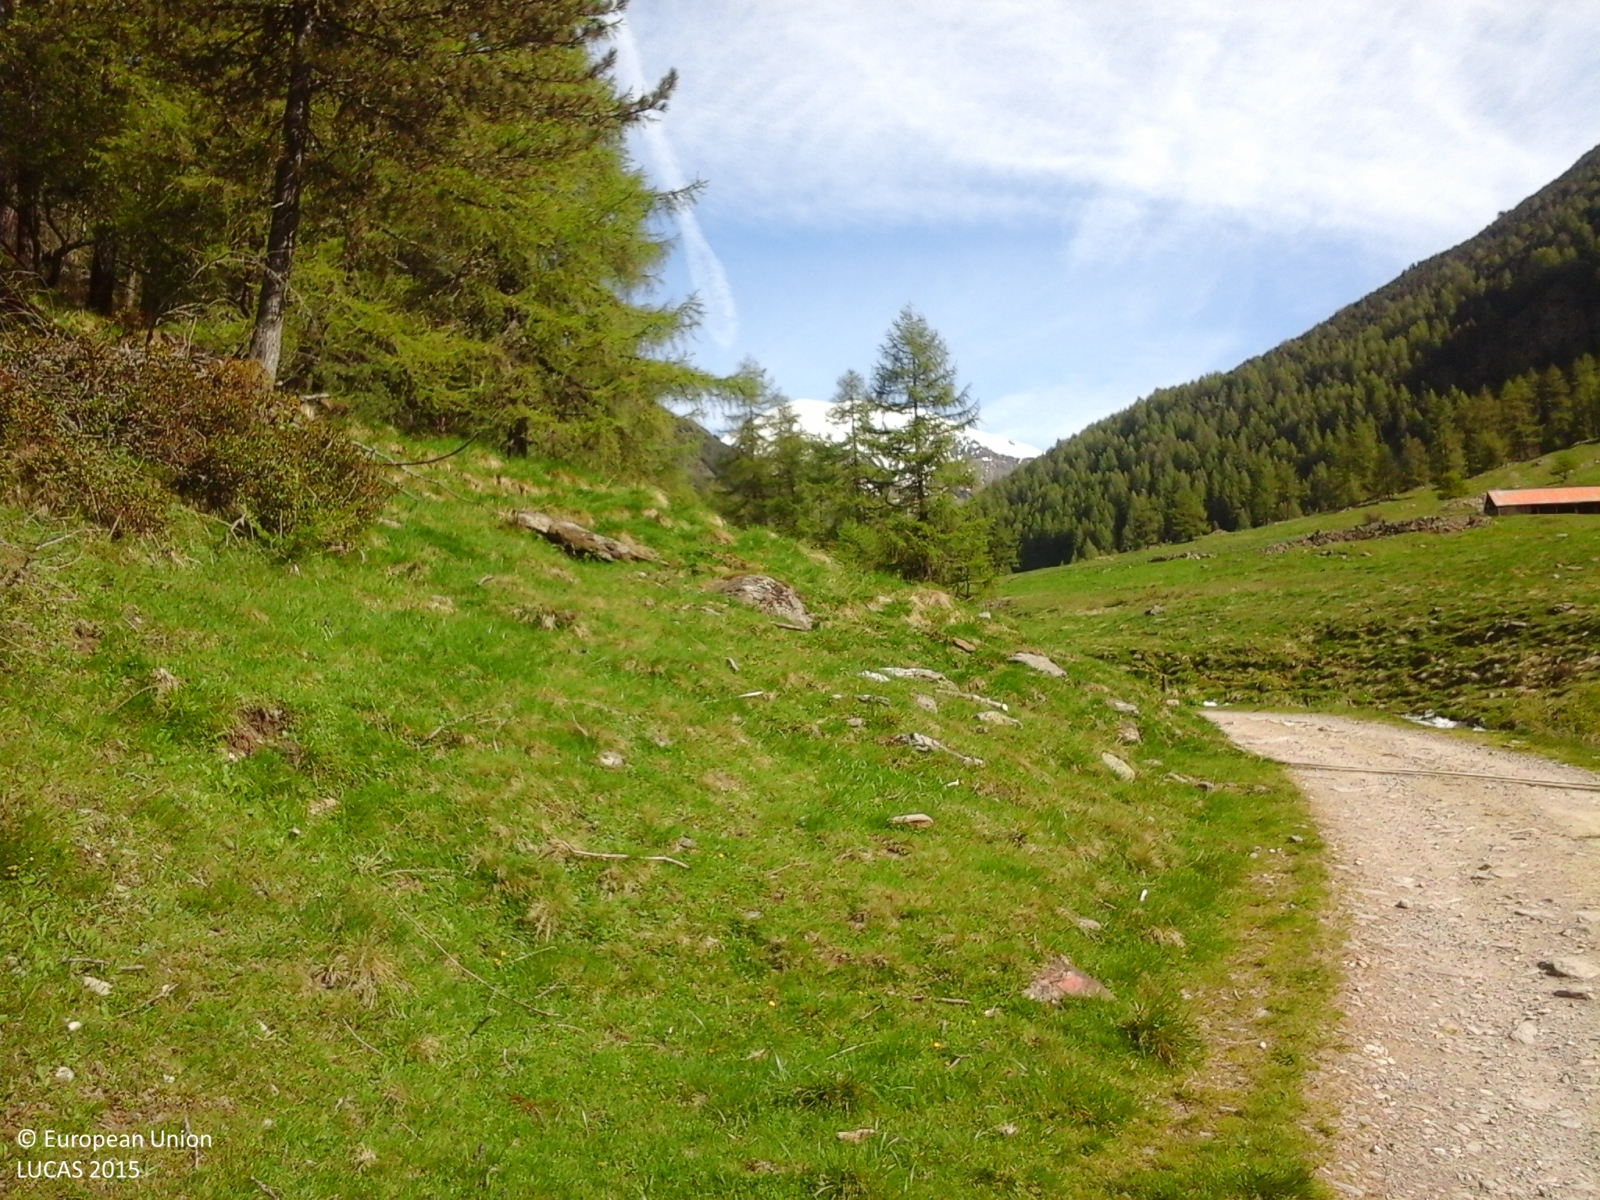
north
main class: Woodland
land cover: Other coniferous woodland
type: alpine coniferous forest
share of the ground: > 75 %
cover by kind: coniferous forest trees 100 %
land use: Forestry
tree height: > 5 m
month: May
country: IT
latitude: 46.6726
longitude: 10.7703
